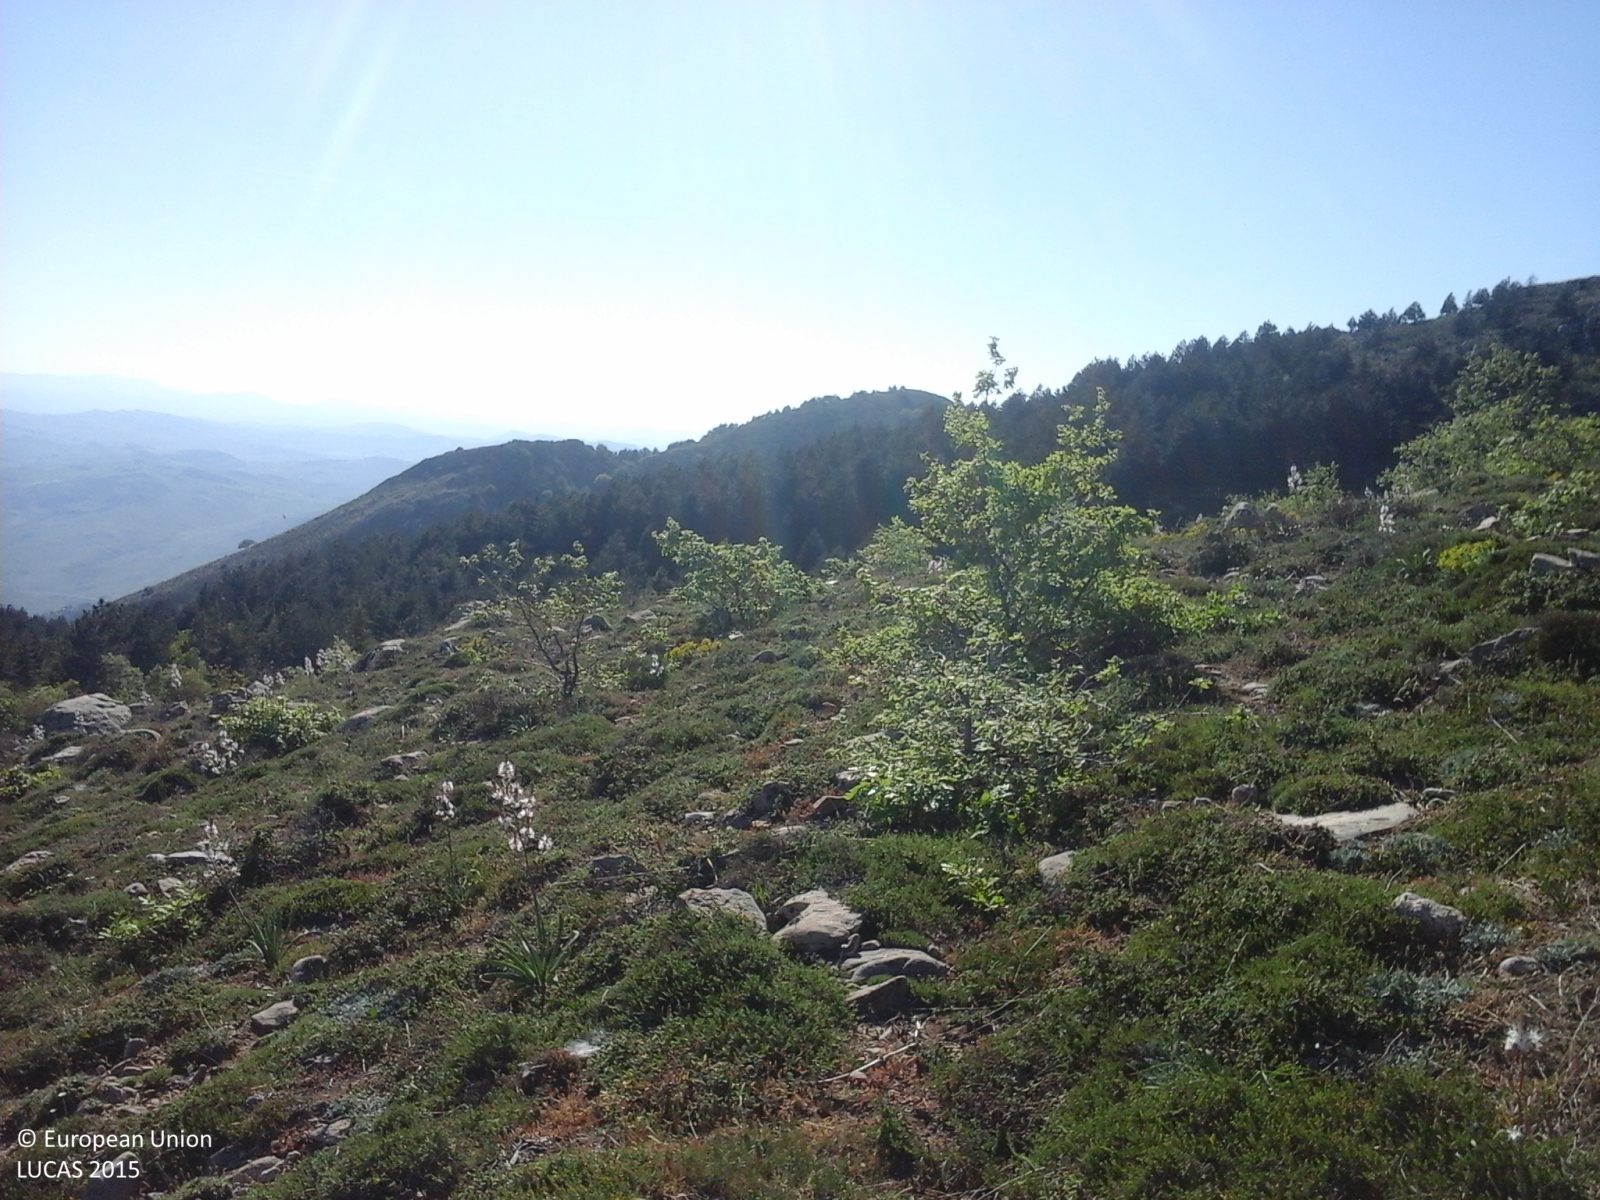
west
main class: Shrubland
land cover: Shrubland with sparse tree cover
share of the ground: > 75 %
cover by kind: shrubs 45 %, herbaceous plants 30 %, consolidated bare surface 15 %, broadleaved forest trees 5 %, unconsolidated bare surface 5 %
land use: Agriculture (excluding fallow land and kitchen gardens)
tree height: < 5 m
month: May
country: IT
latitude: 37.8248
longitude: 14.0497
